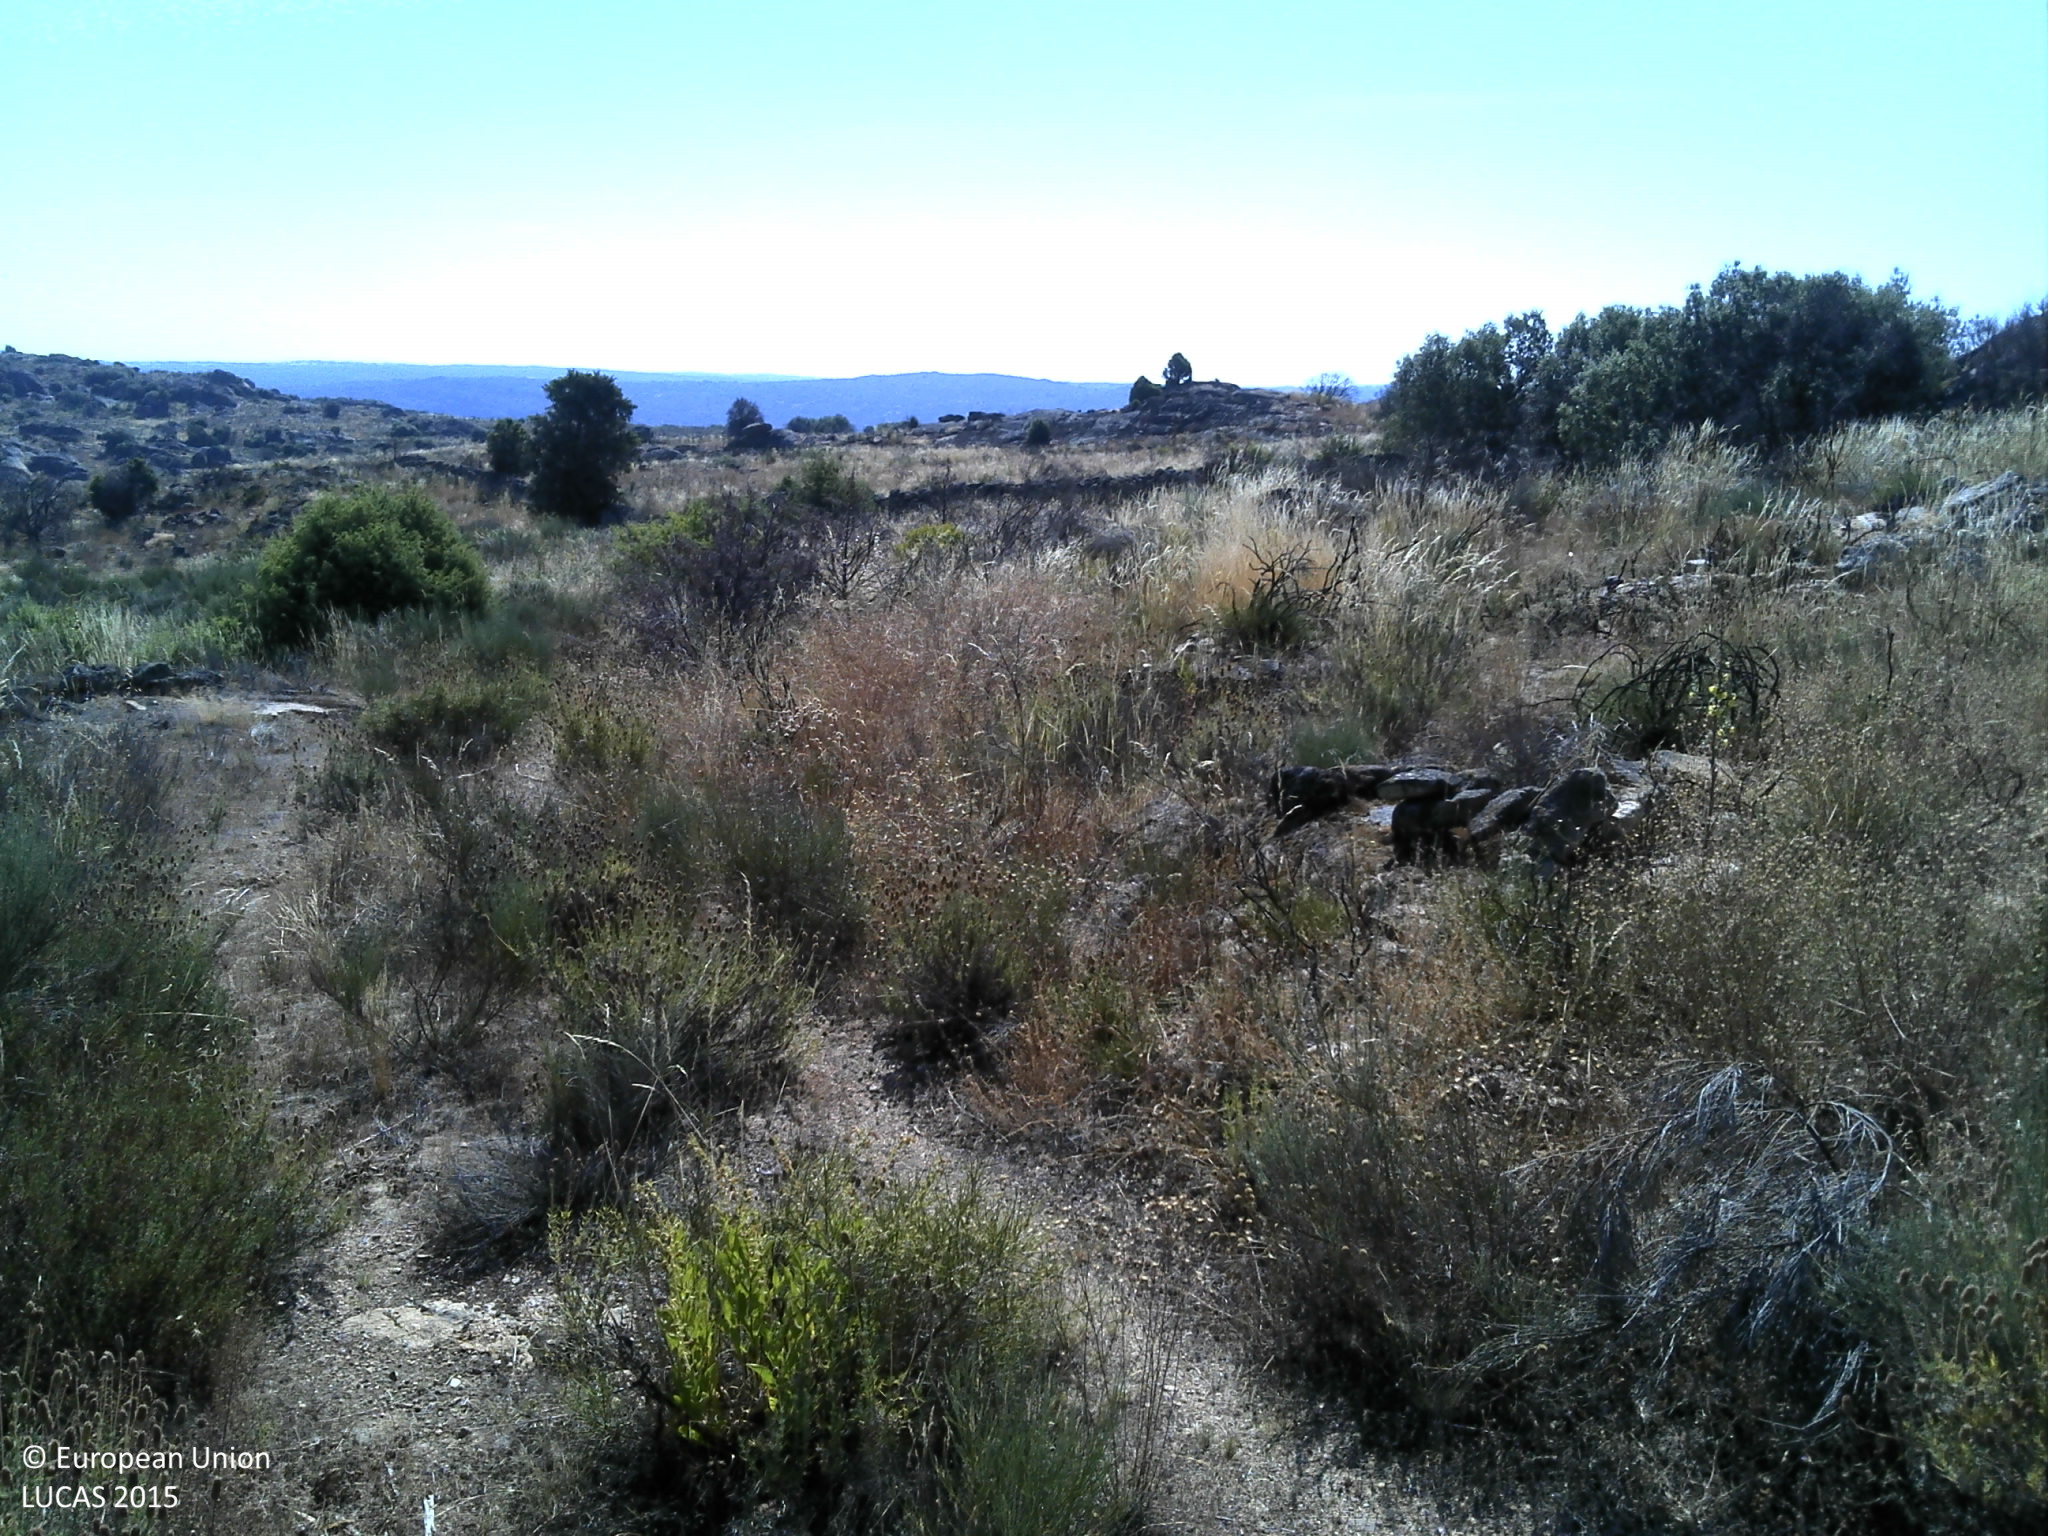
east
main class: Shrubland
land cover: Shrubland with sparse tree cover
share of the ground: > 75 %
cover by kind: shrubs 95 %, coniferous forest trees 5 %
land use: Semi-natural and natural areas not in use
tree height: < 5 m
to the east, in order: Shrubland with sparse tree cover; Tracks; Shrubland with sparse tree cover; Rock outcrops; Spontaneously vegetated surfaces; Dry stone walls; Spontaneously vegetated surfaces; Rock outcrops; Grassland with sparse tree/shrub cover; Rock outcrops; Spontaneously vegetated surfaces; Rocks and stones; Spontaneously vegetated surfaces; Rocks and stones; Spontaneously vegetated surfaces; Rocks and stones
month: June
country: PT
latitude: 40.9475
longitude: -6.8885
